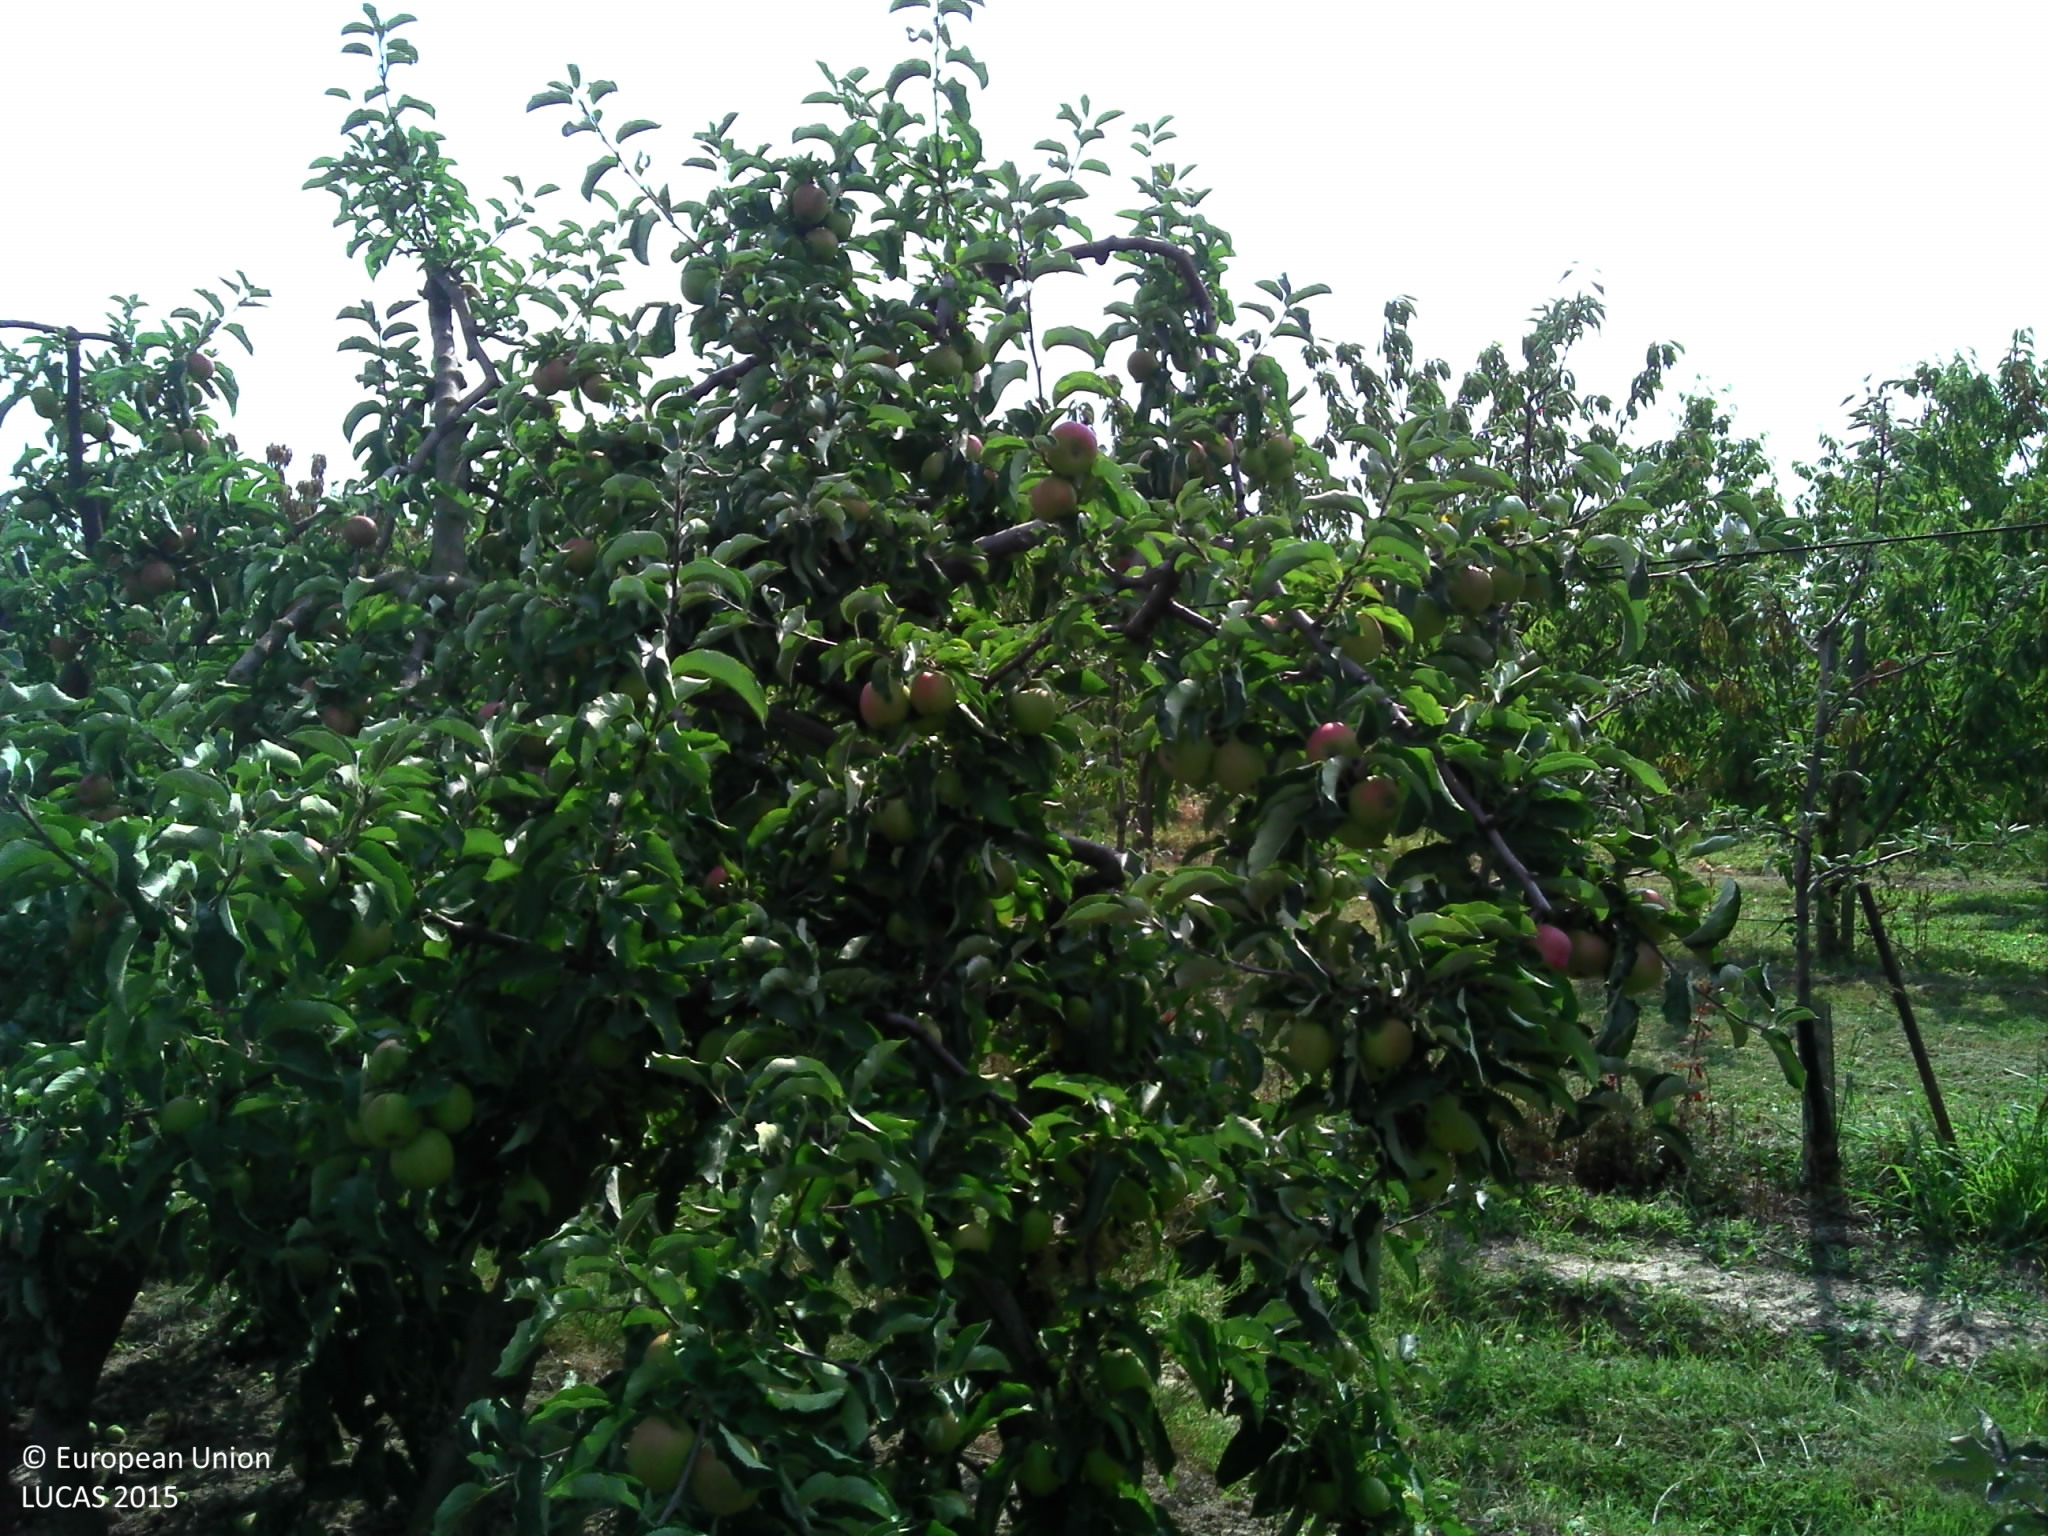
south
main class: Cropland
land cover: Apple fruit
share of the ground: 50 - 75 %
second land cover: Grassland without tree/shrub cover
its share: 25 - 50 %
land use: Agriculture (excluding fallow land and kitchen gardens)
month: August
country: FR
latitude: 50.2591
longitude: 3.6388
